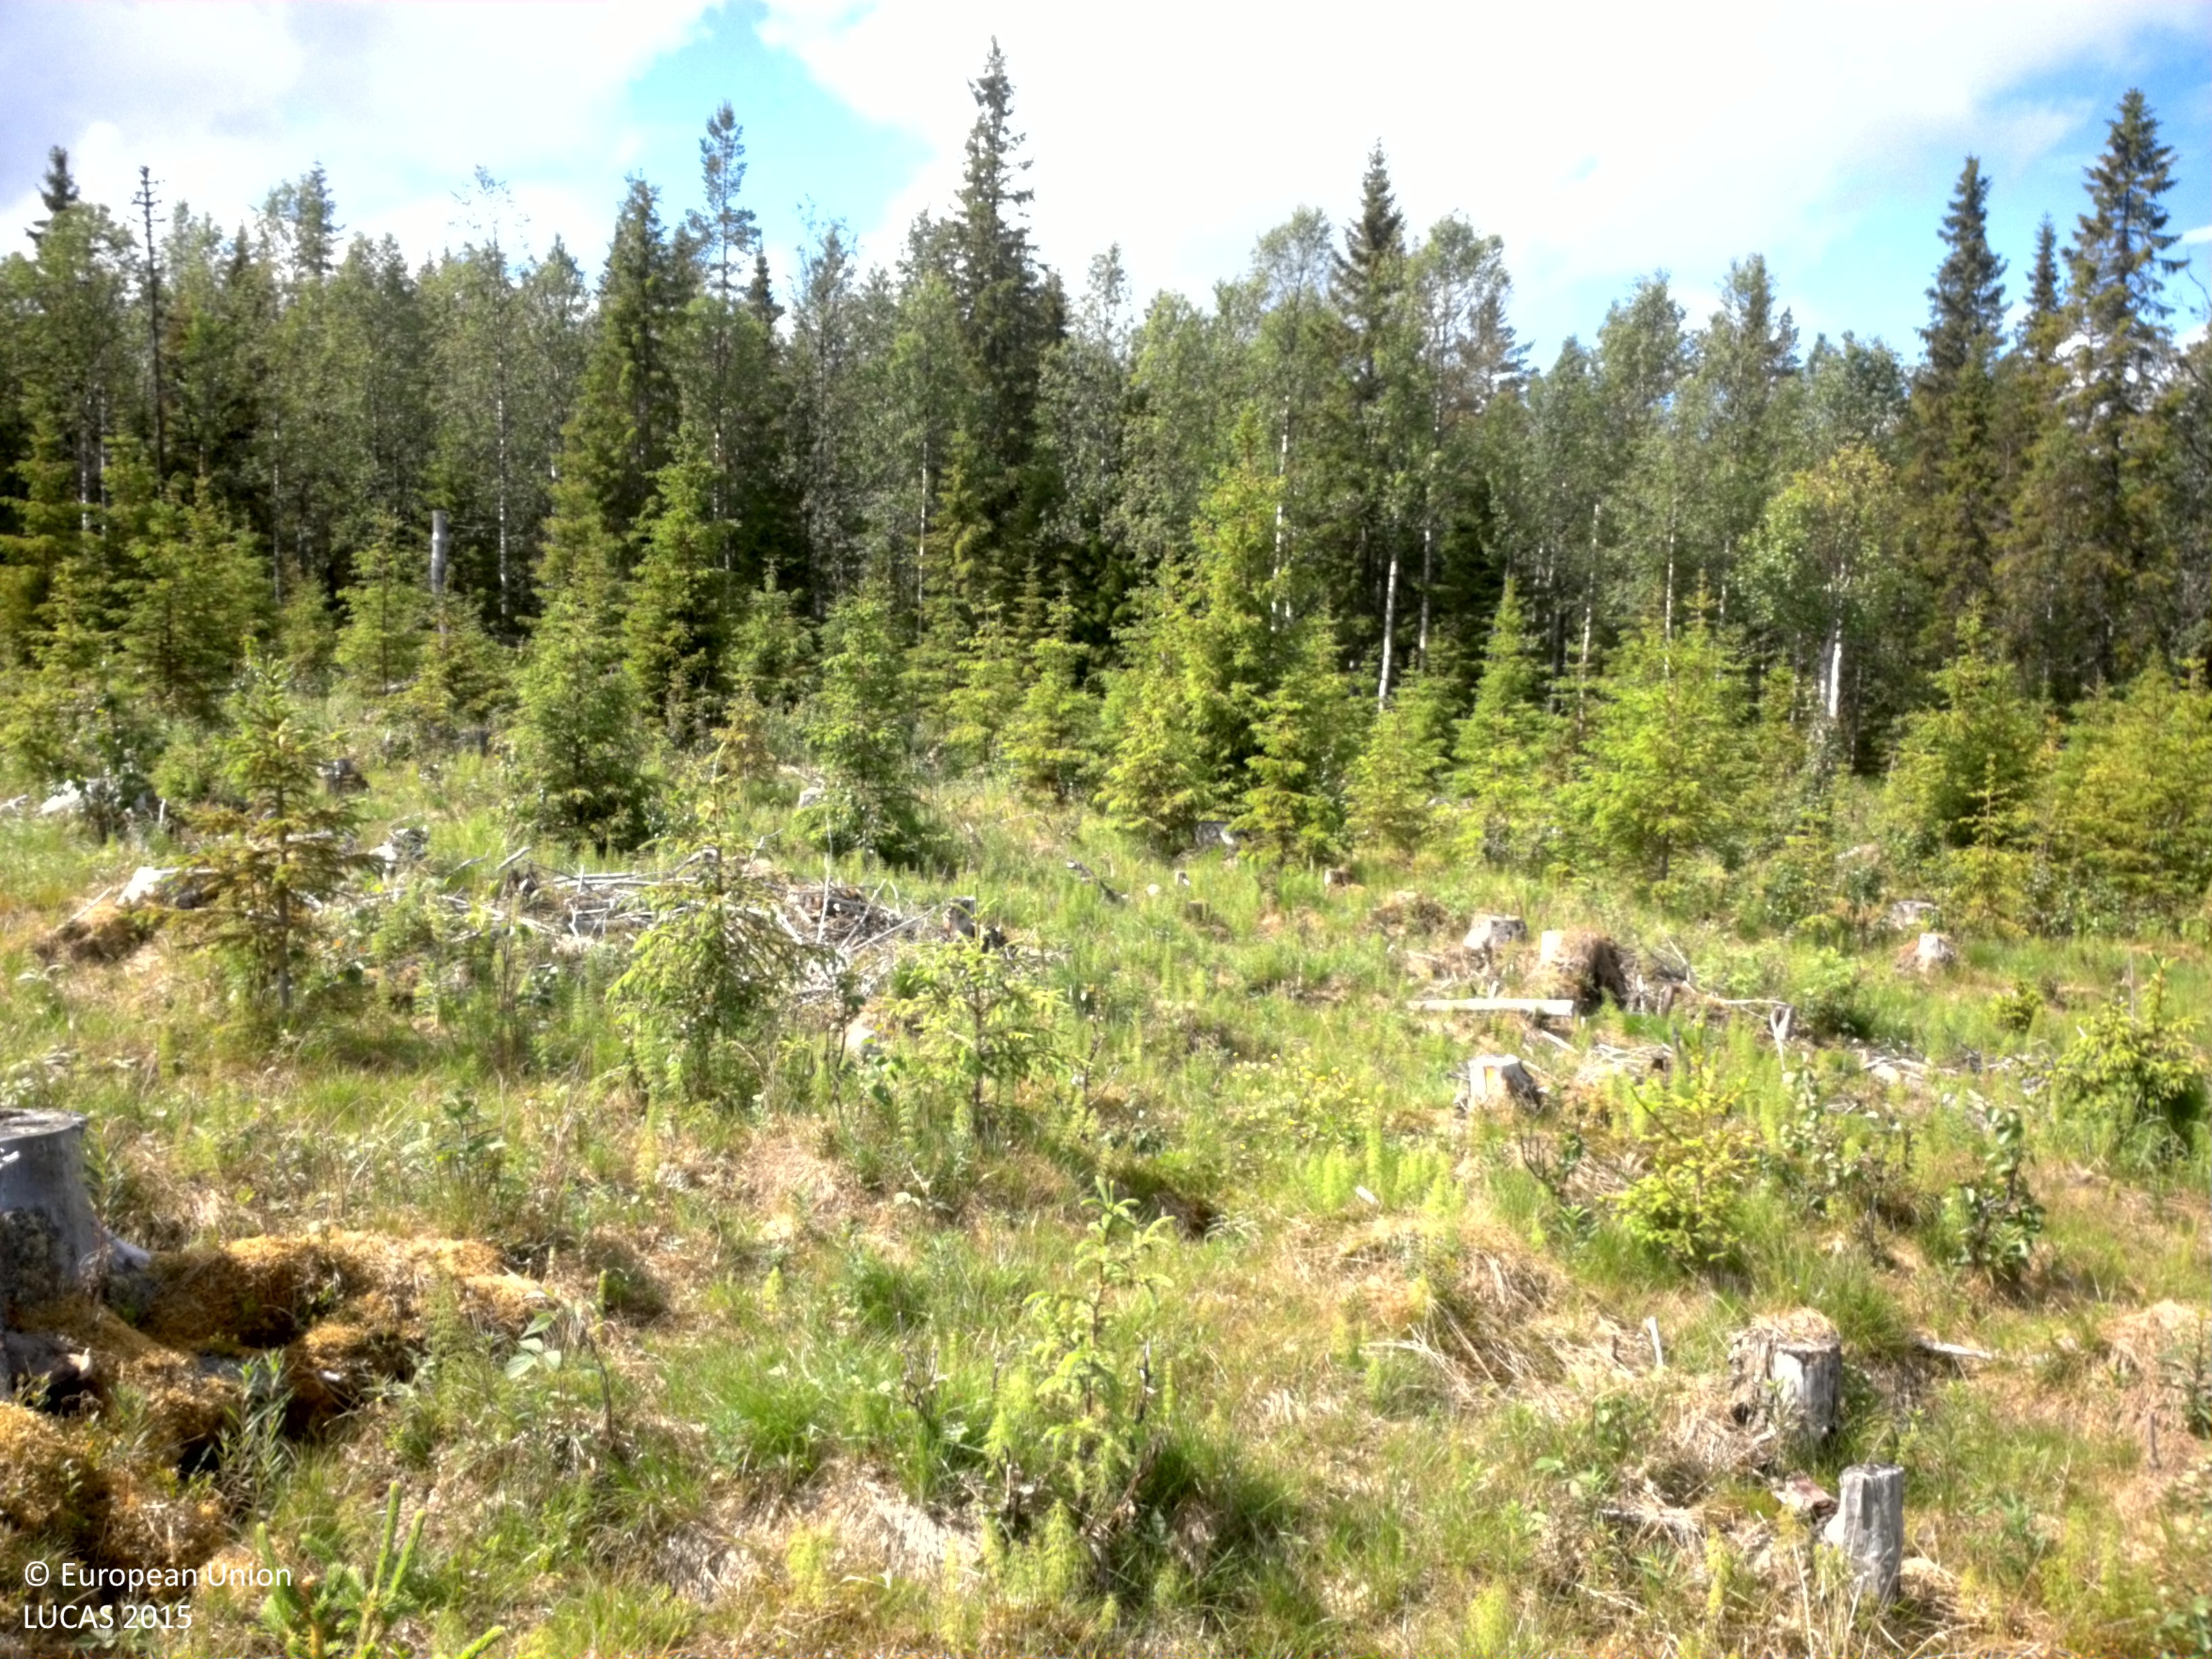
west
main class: Woodland
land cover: Spruce dominated mixed woodland
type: boreal forest
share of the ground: 50 - 75 %
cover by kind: coniferous forest trees 45 %, broadleaved forest trees 30 %, herbaceous plants 20 %, shrubs 5 %
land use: Forestry
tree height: < 5 m
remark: Clear cut
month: July
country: SE
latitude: 64.4796
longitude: 18.1435
